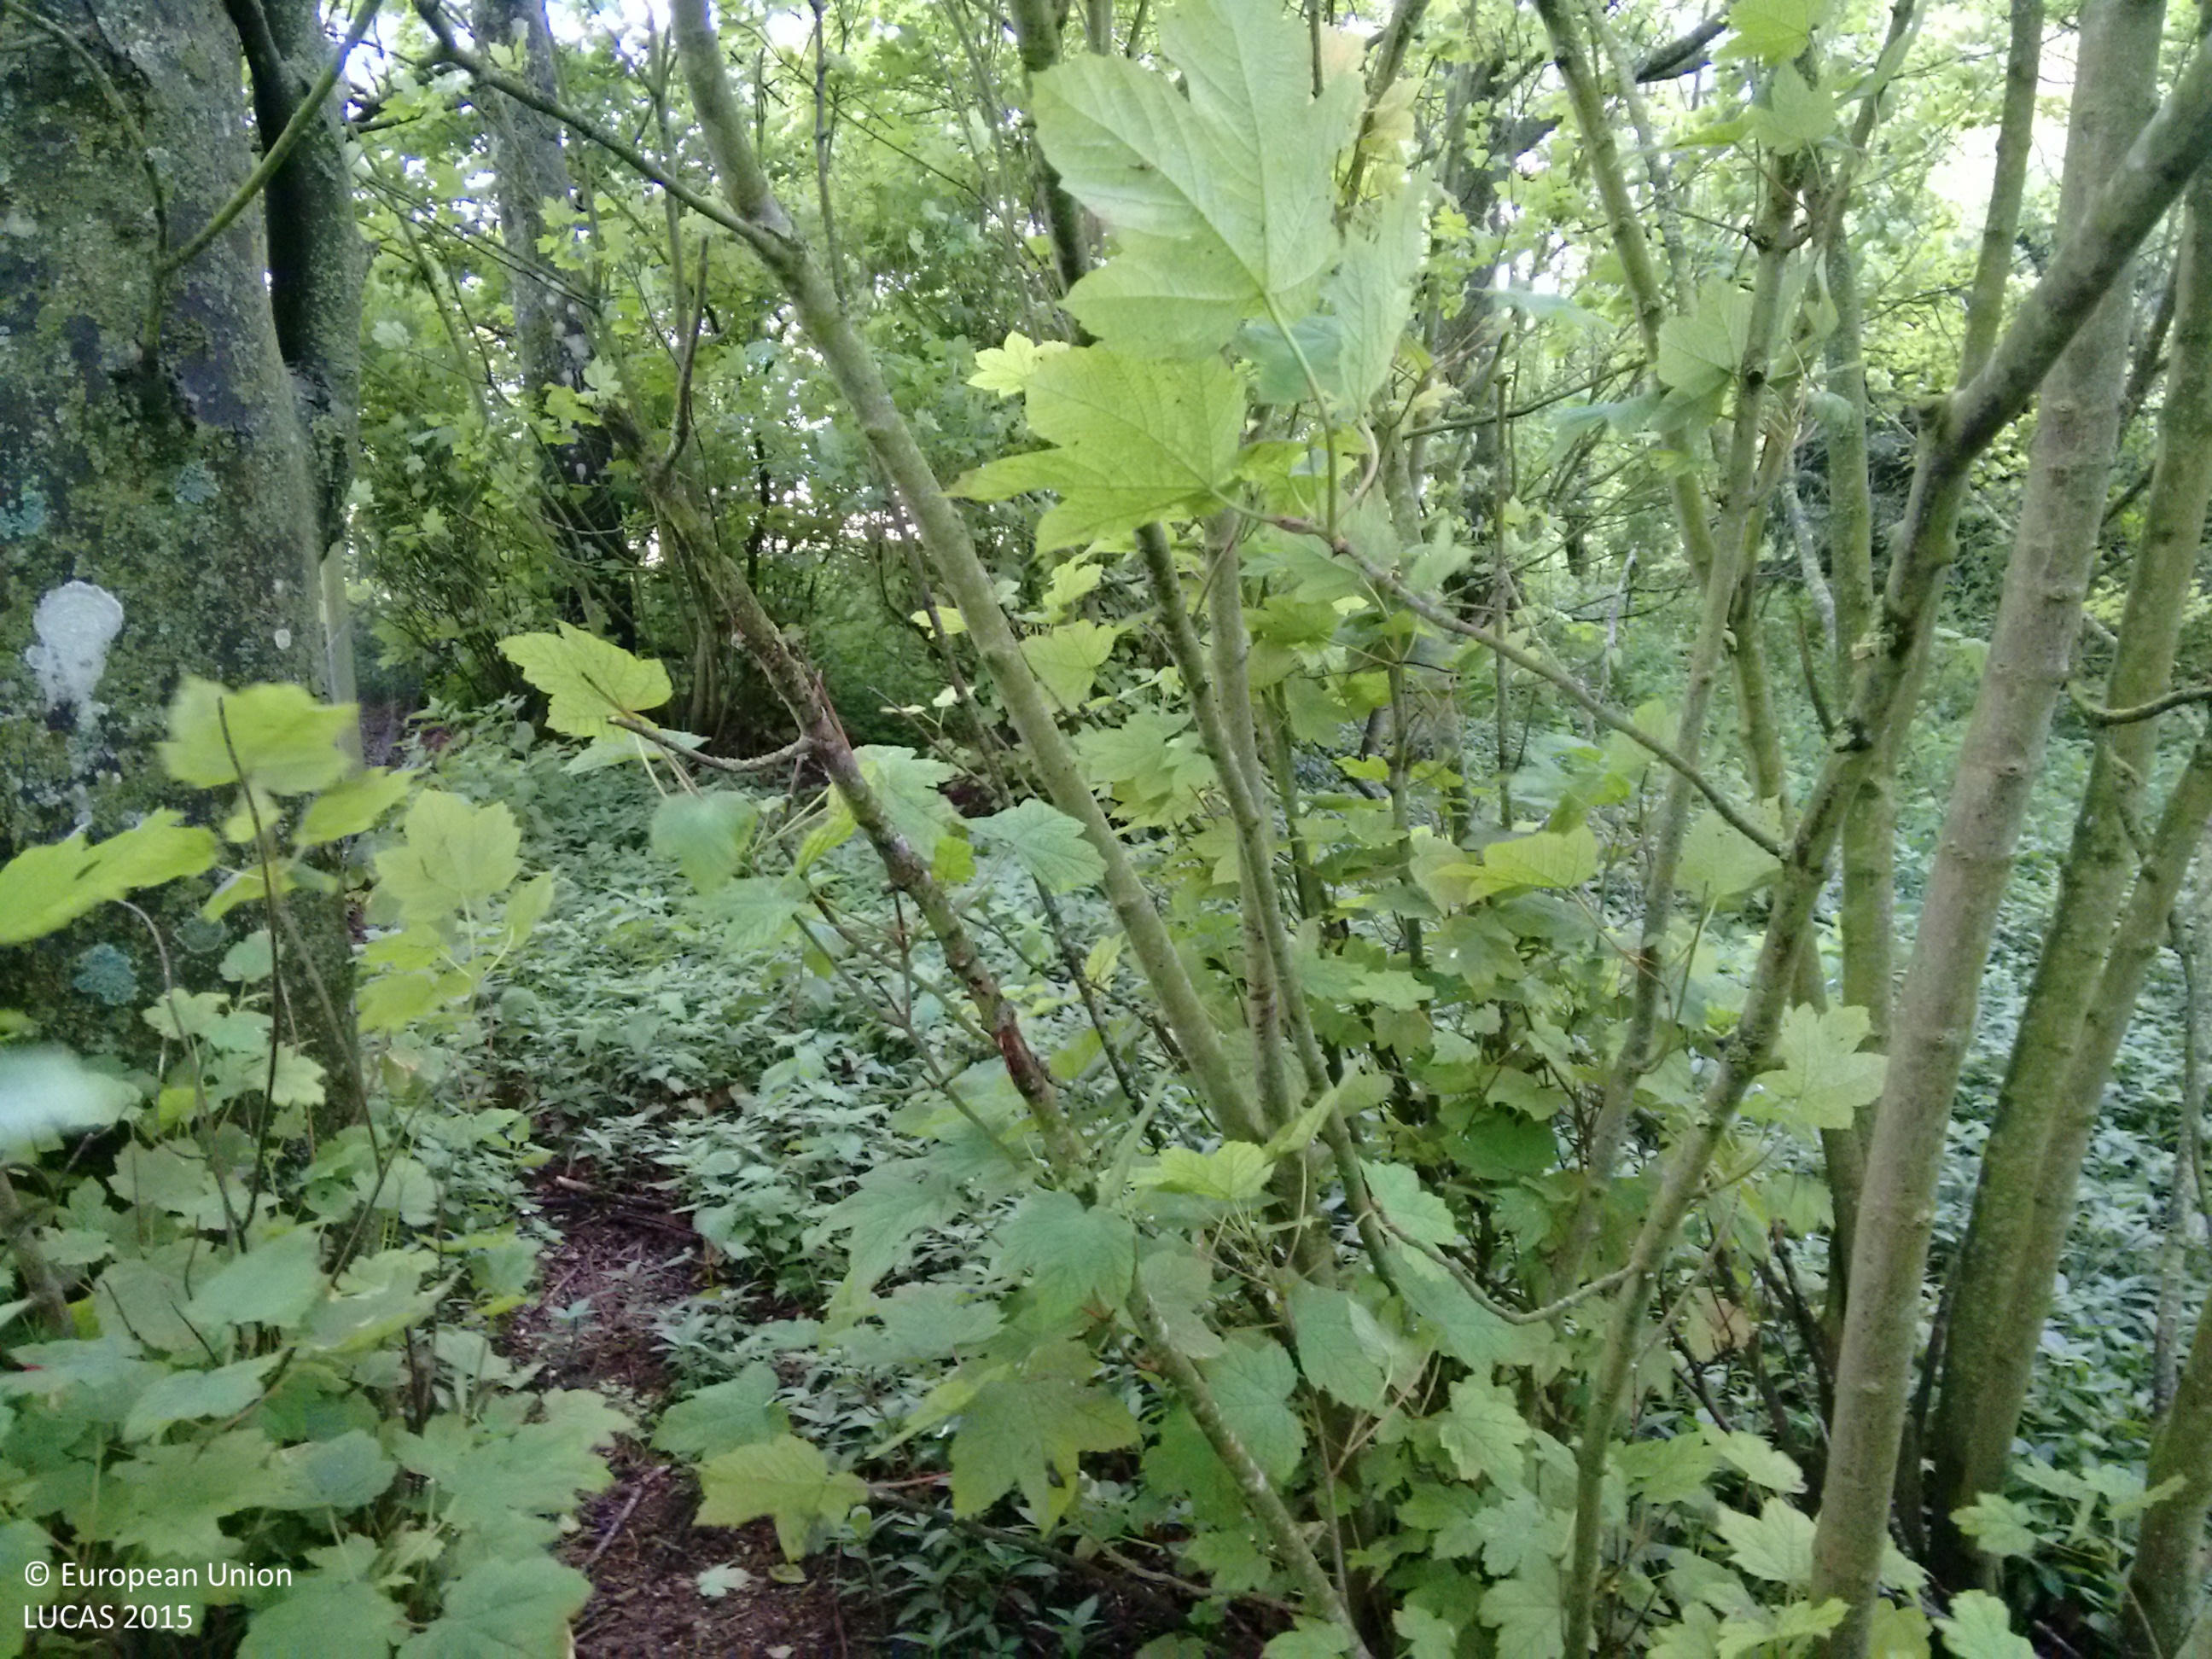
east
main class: Woodland
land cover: Broadleaved woodland
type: mesophytic deciduous forest
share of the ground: > 75 %
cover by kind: broadleaved forest trees 90 %, shrubs 10 %
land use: Agriculture (excluding fallow land and kitchen gardens)
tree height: > 5 m
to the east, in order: Broadleaved woodland; Fences; Grassland without tree/shrub cover; Fences; Grassland without tree/shrub cover; Fences; Grassland without tree/shrub cover; Tracks; Grass margins; Permanent industrial crops; Artificial constructions in urban areas; Broadleaved woodland; Oats
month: June
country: GB
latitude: 51.1598
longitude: -1.1568
